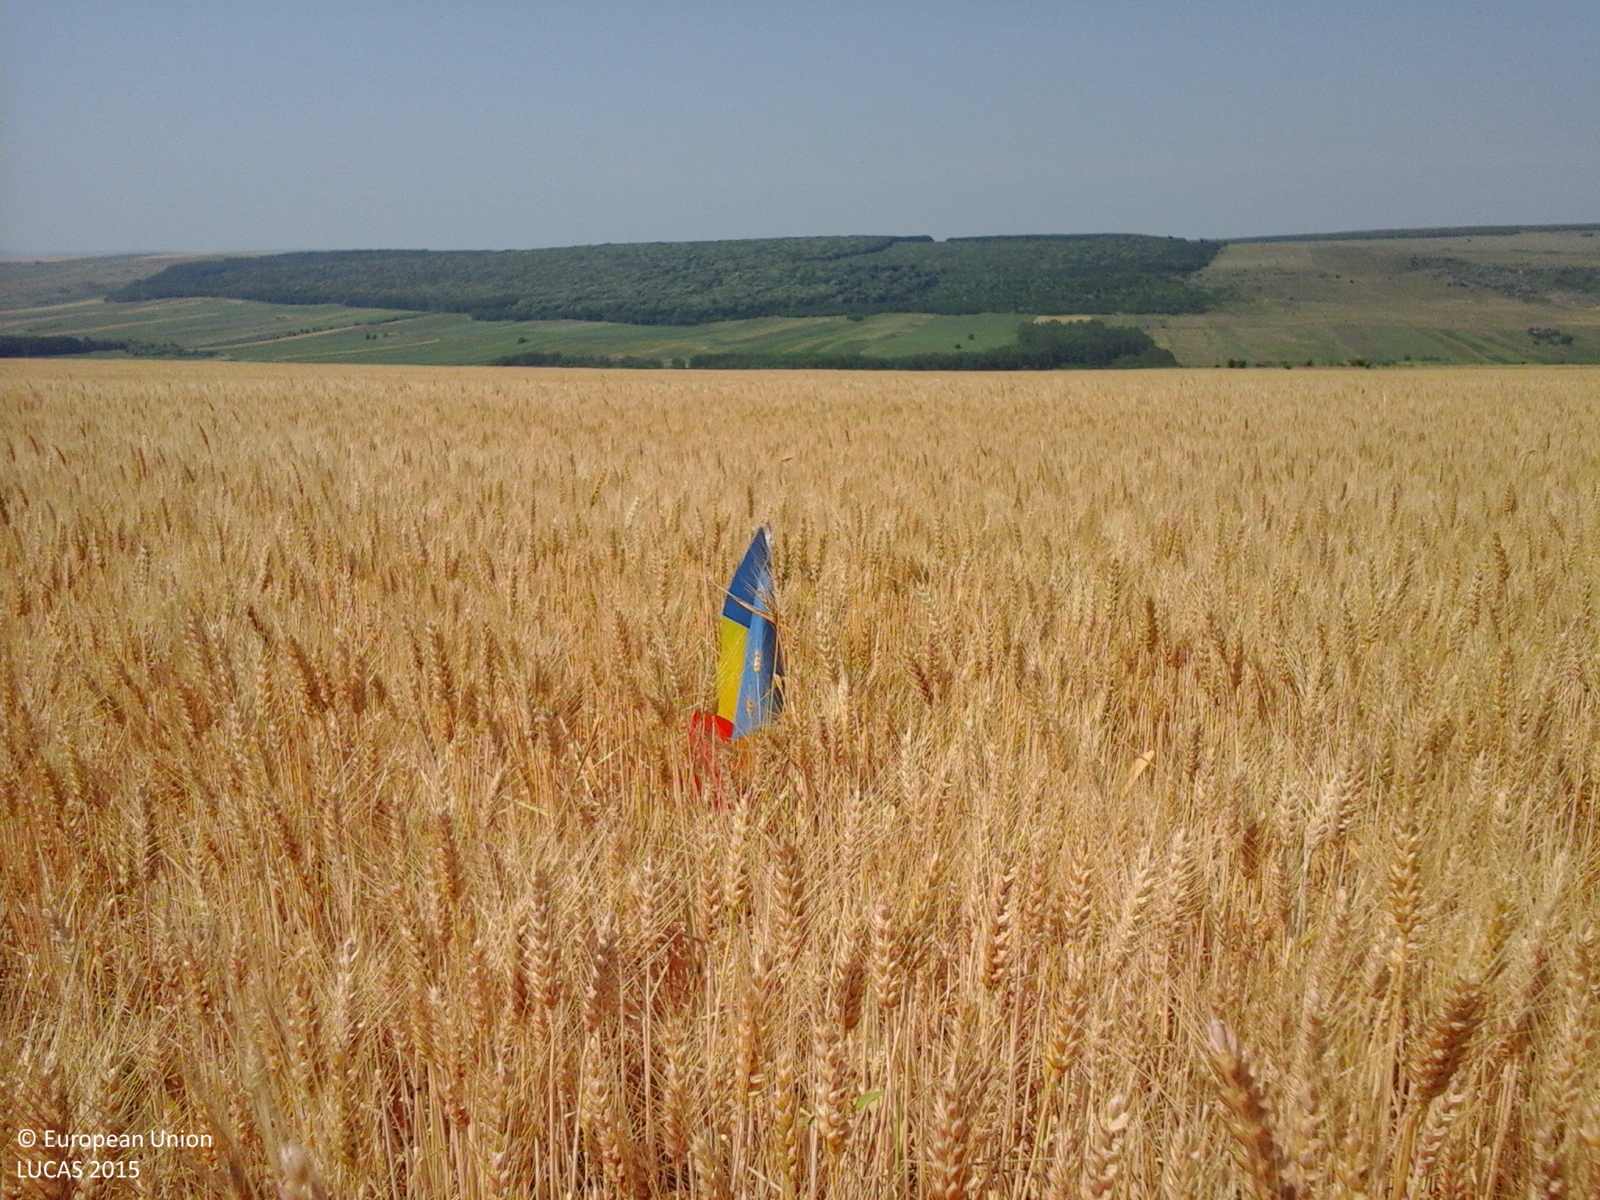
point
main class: Cropland
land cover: Common wheat
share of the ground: > 75 %
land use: Agriculture (excluding fallow land and kitchen gardens)
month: June
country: RO
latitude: 46.9575
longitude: 27.8250
